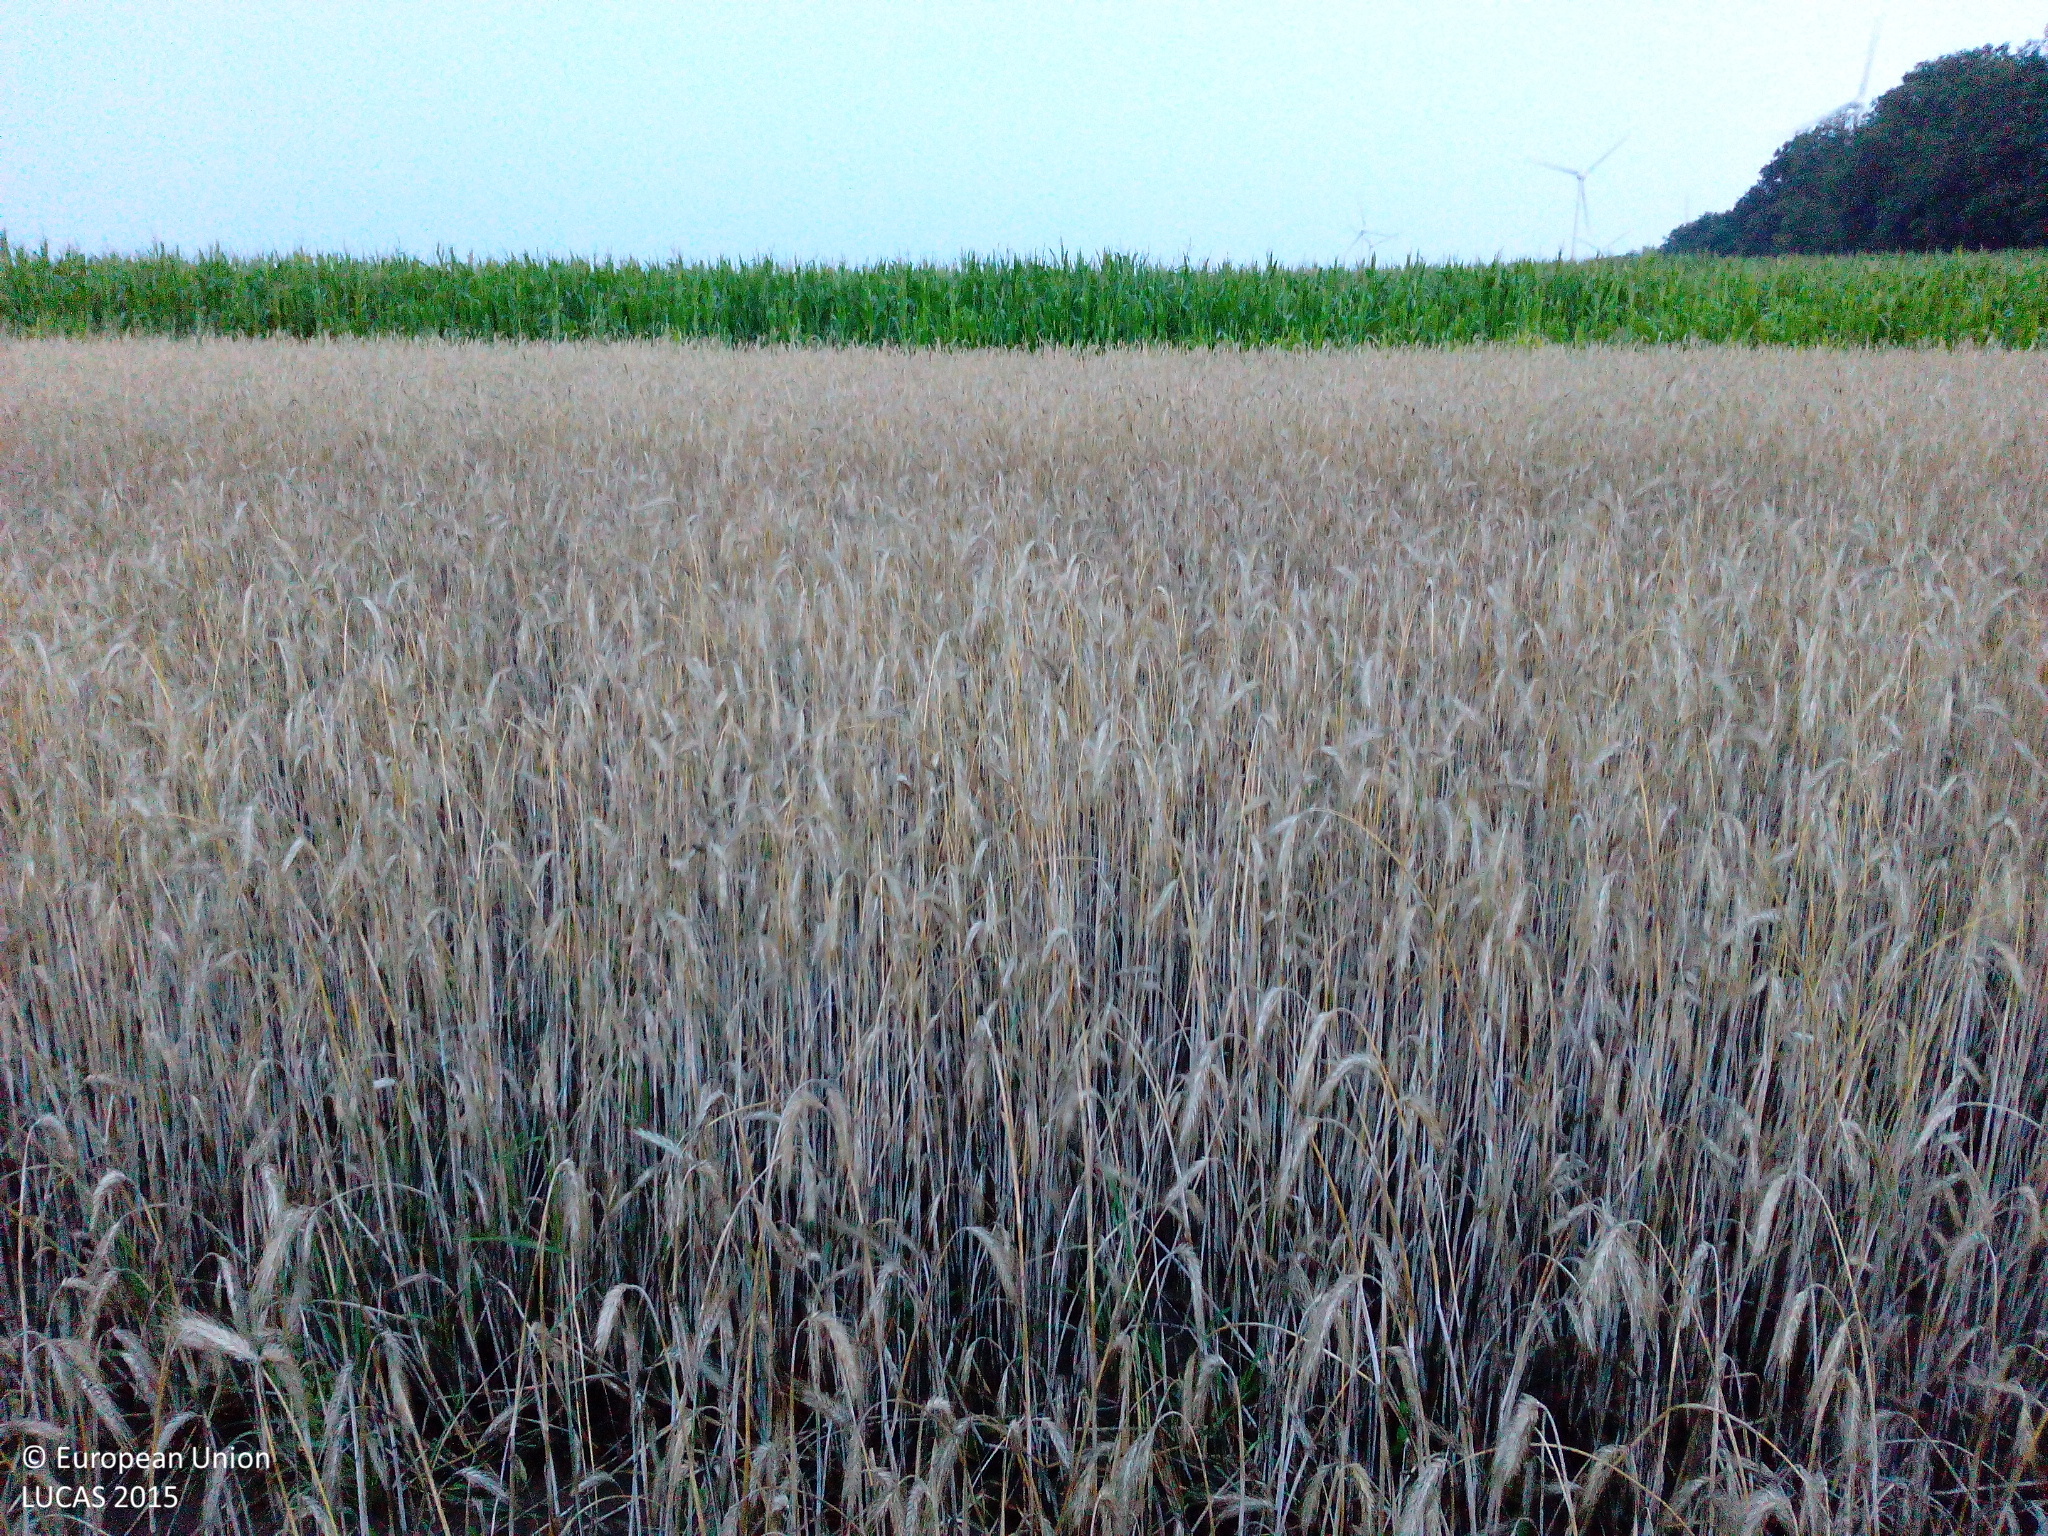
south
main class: Cropland
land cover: Rye
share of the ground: > 75 %
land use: Agriculture (excluding fallow land and kitchen gardens)
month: July
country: DE
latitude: 53.1617
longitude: 12.4373
